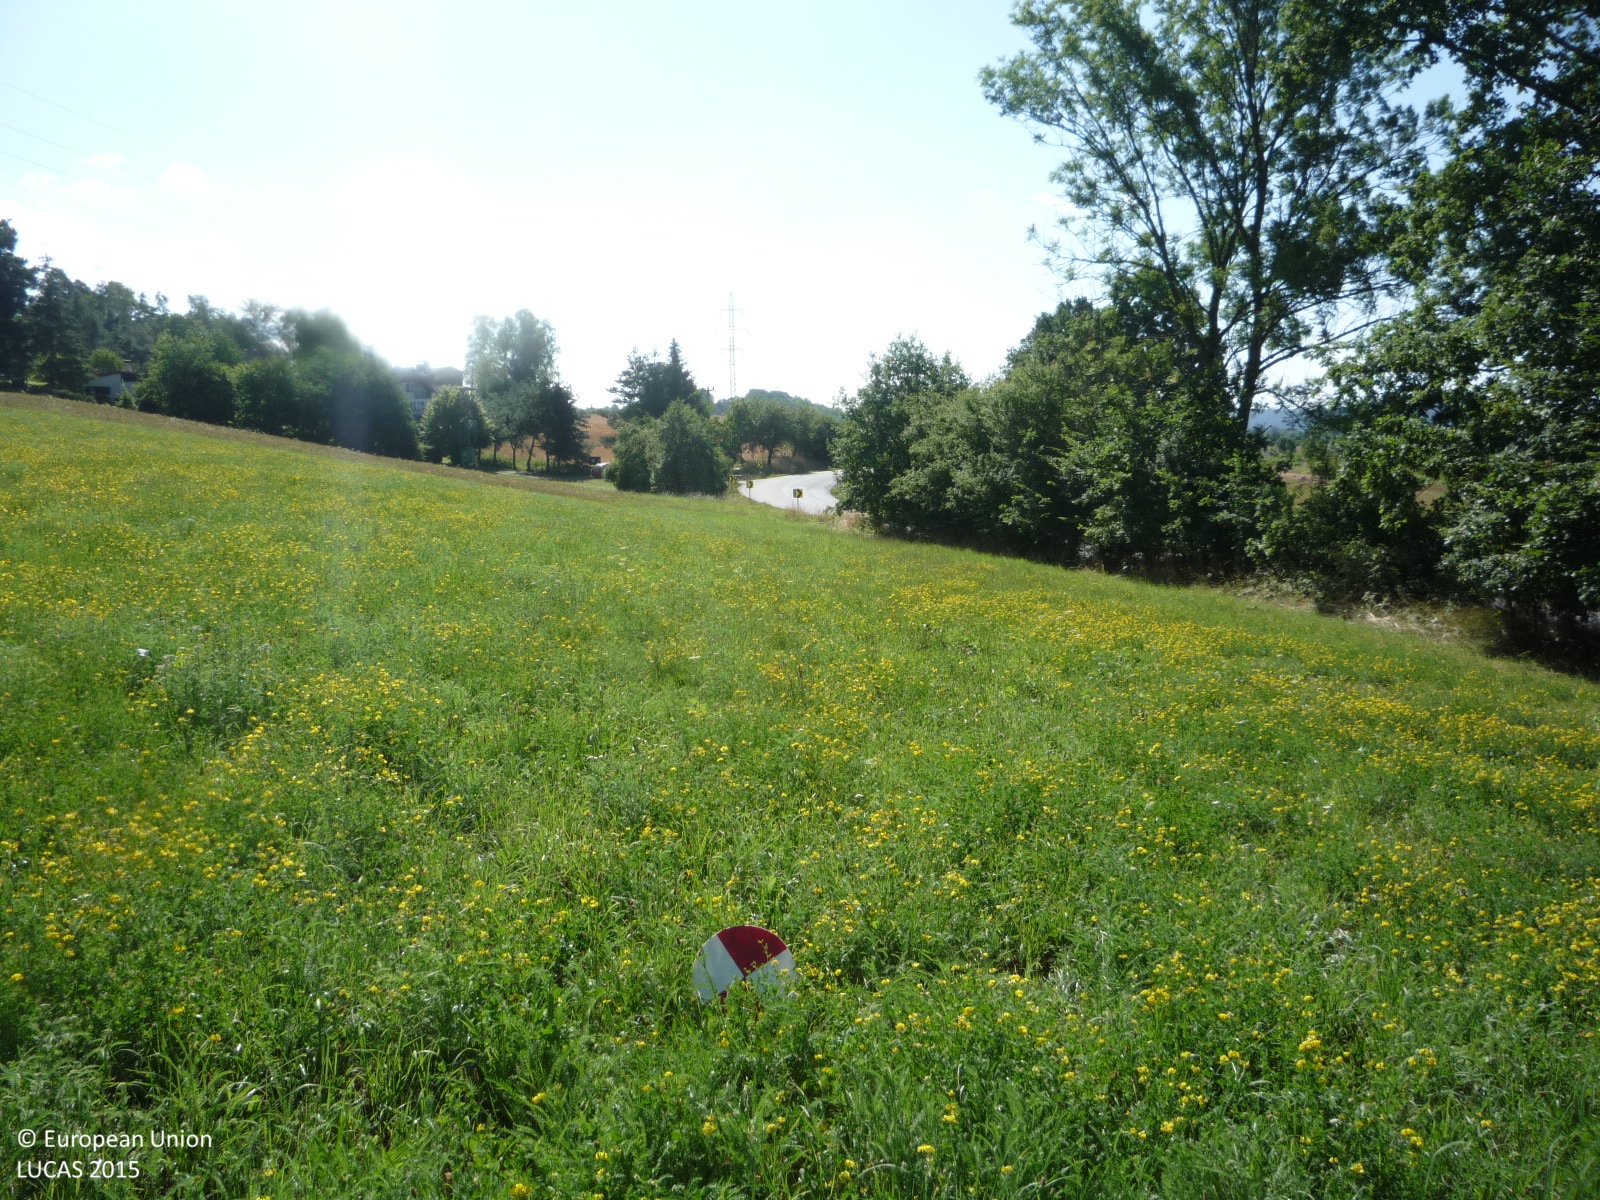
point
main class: Grassland
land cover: Grassland without tree/shrub cover
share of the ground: > 75 %
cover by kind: herbaceous plants 100 %
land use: Agriculture (excluding fallow land and kitchen gardens)
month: July
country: CZ
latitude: 50.5324
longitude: 15.2375
